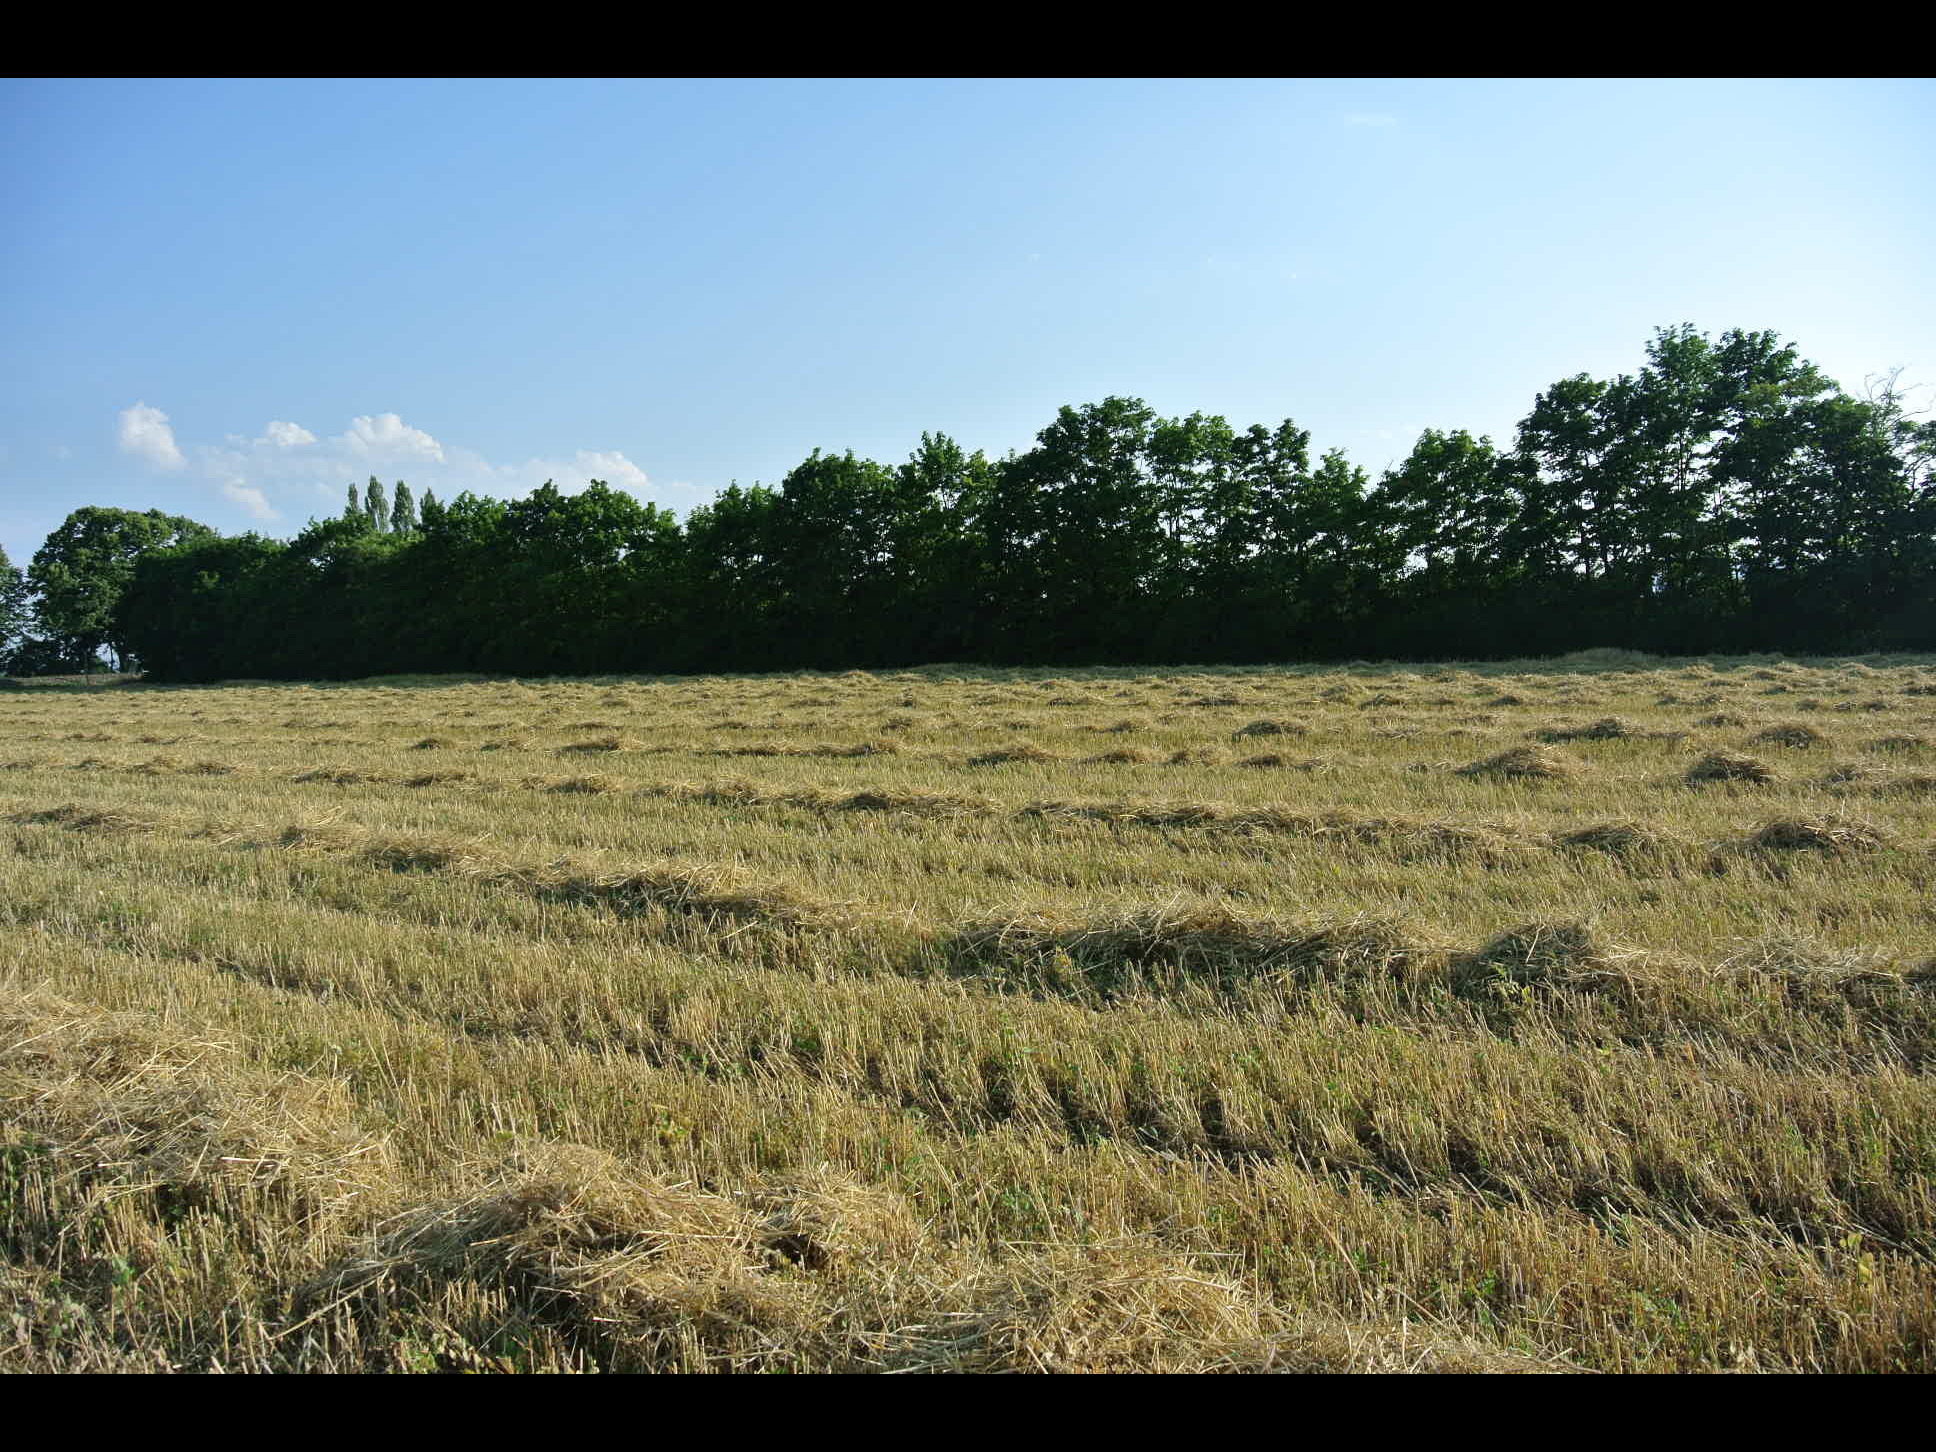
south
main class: Cropland
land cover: Oats
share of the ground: > 75 %
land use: Agriculture (excluding fallow land and kitchen gardens)
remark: Harvested field
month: July
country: AT
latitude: 47.8181
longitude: 16.1337
